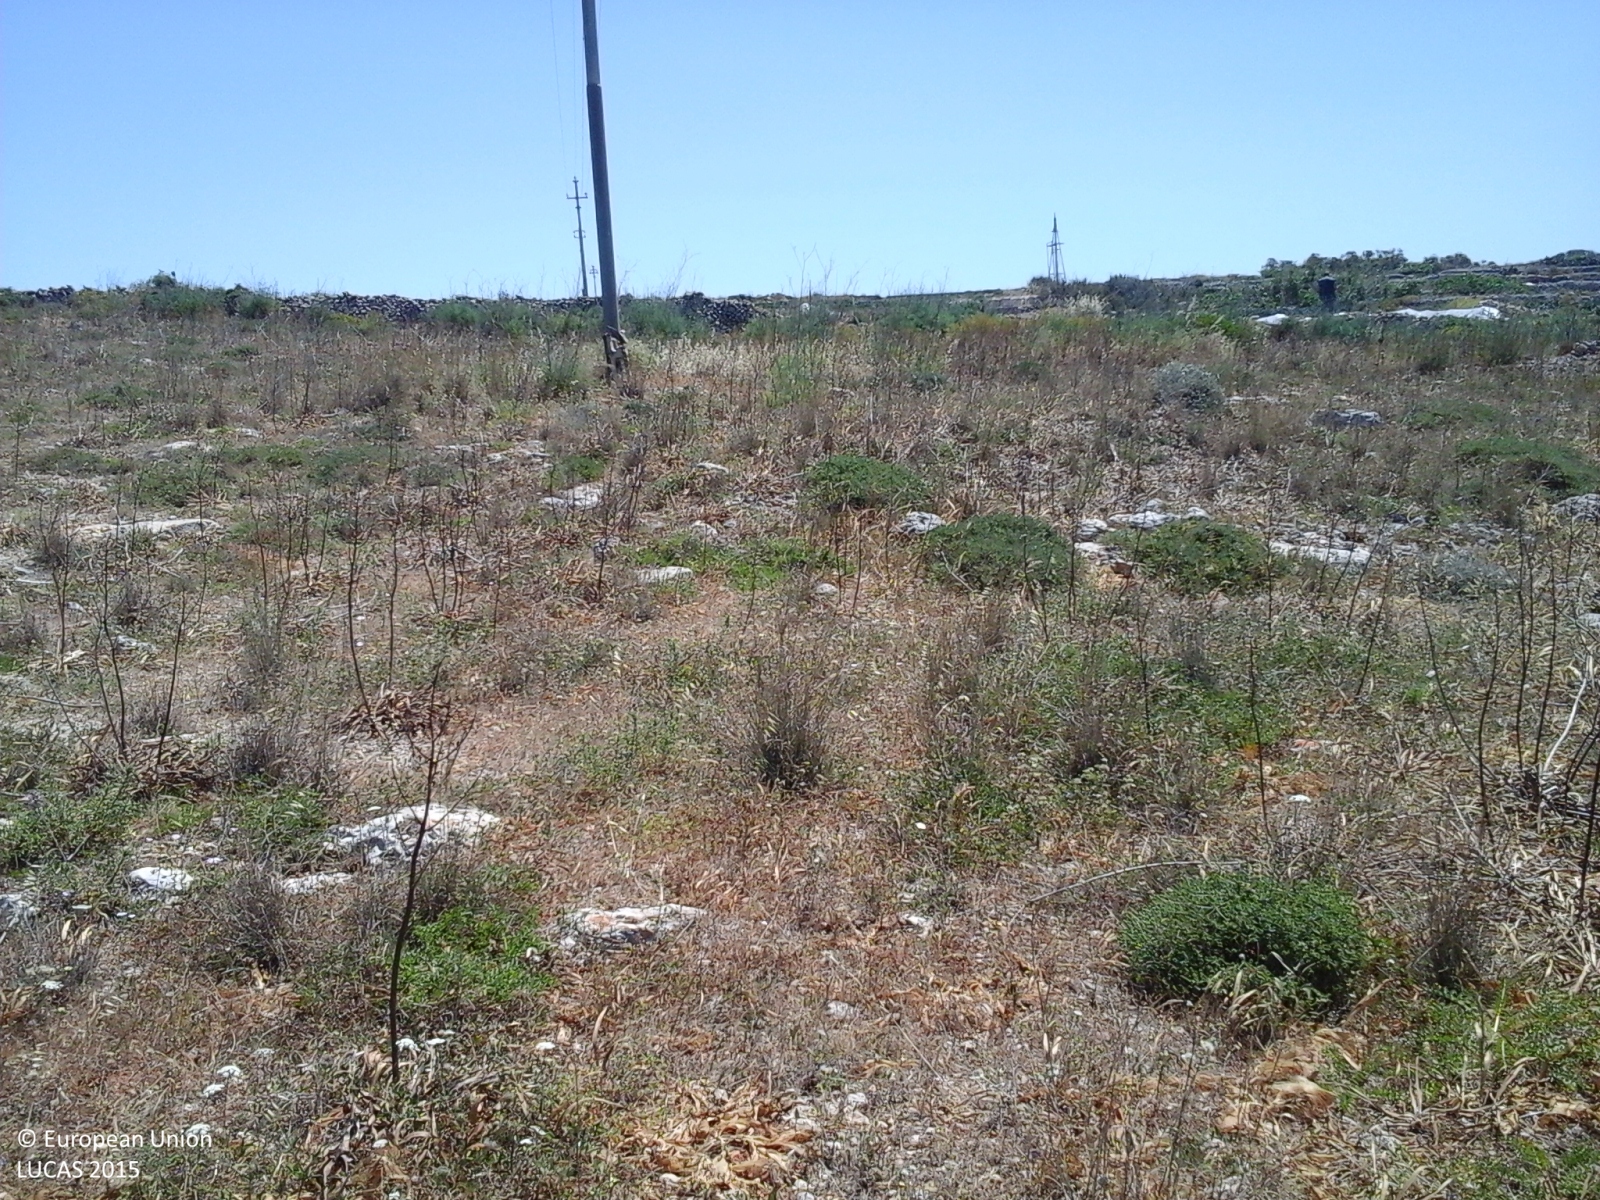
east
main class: Shrubland
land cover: Shrubland without tree cover
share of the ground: > 75 %
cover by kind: shrubs 50 %, herbaceous plants 30 %, consolidated bare surface 20 %
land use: Semi-natural and natural areas not in use
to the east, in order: Shrubland without tree cover; Dry stone walls; Other fresh vegetables; Electric lines; Other fresh vegetables; Tracks; Grass margins; Other root crops; Tracks; Dry stone walls; Other root crops; Grass margins; Other root crops; Grass margins; Paved roads, cycling and walking lanes; Dry stone walls; Managed hedges; Triticale
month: May
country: MT
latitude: 35.8826
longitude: 14.3571
